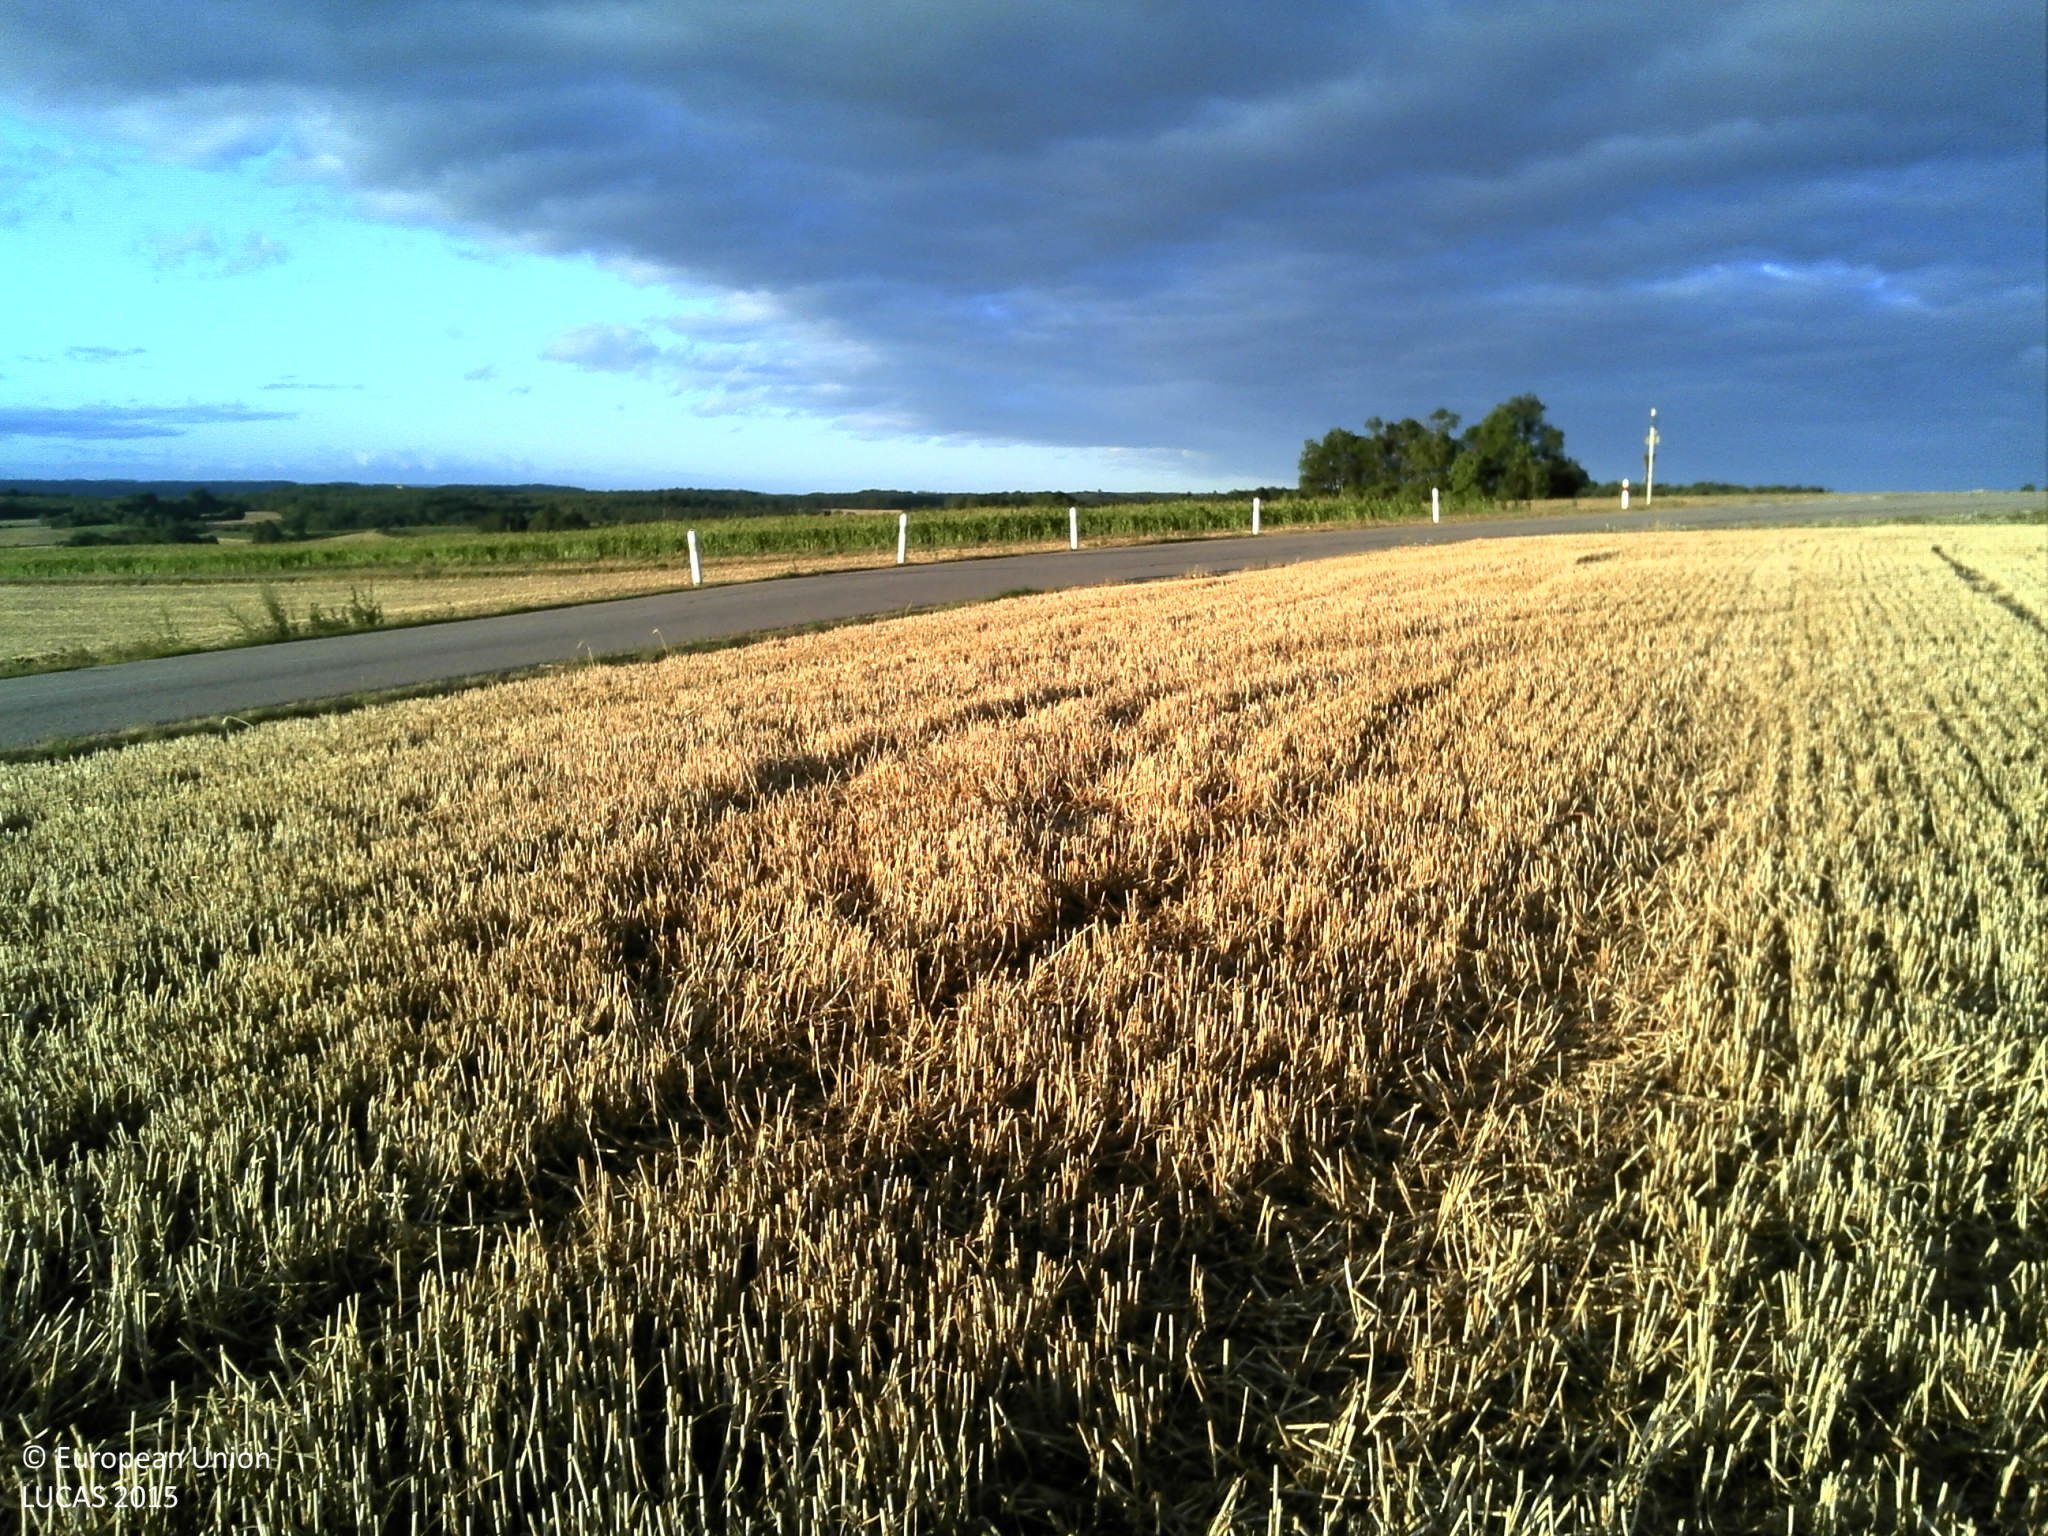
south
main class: Cropland
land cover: Durum wheat
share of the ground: < 10 %
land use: Agriculture (excluding fallow land and kitchen gardens)
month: July
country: FR
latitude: 48.2344
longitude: 6.3250
